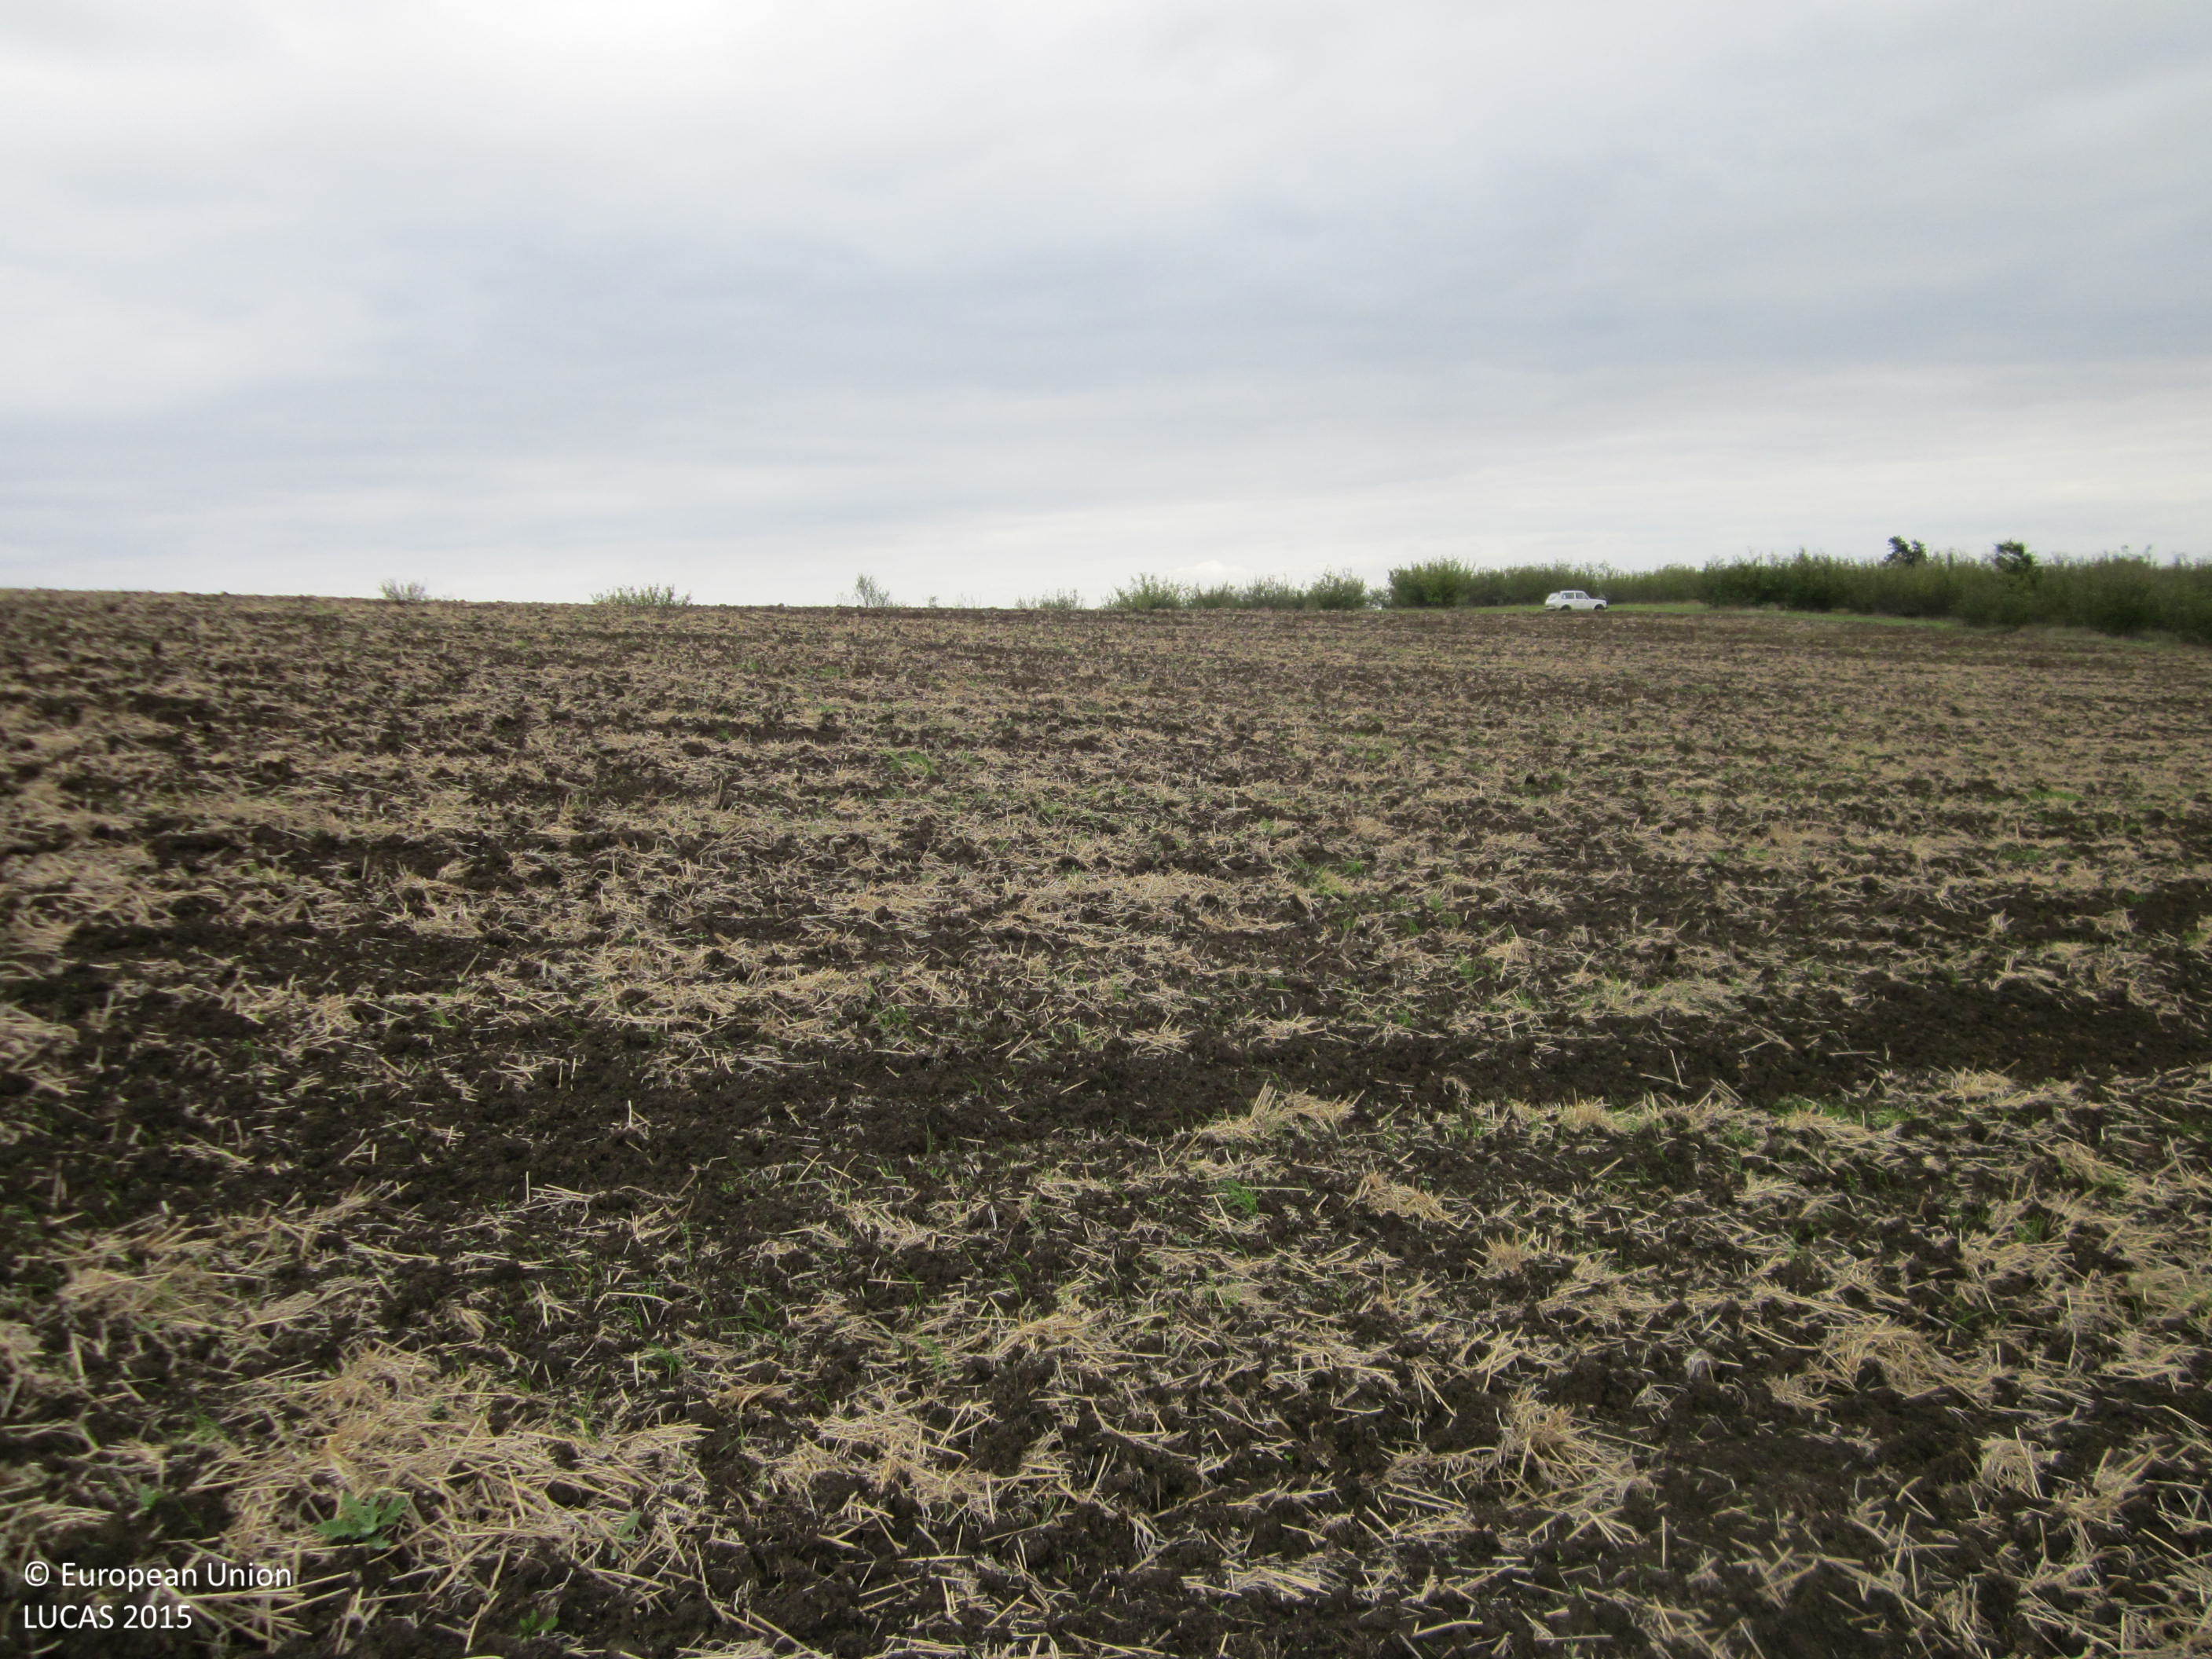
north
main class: Cropland
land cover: Common wheat
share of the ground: < 10 %
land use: Agriculture (excluding fallow land and kitchen gardens)
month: October
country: BG
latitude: 42.3739
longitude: 26.9455
